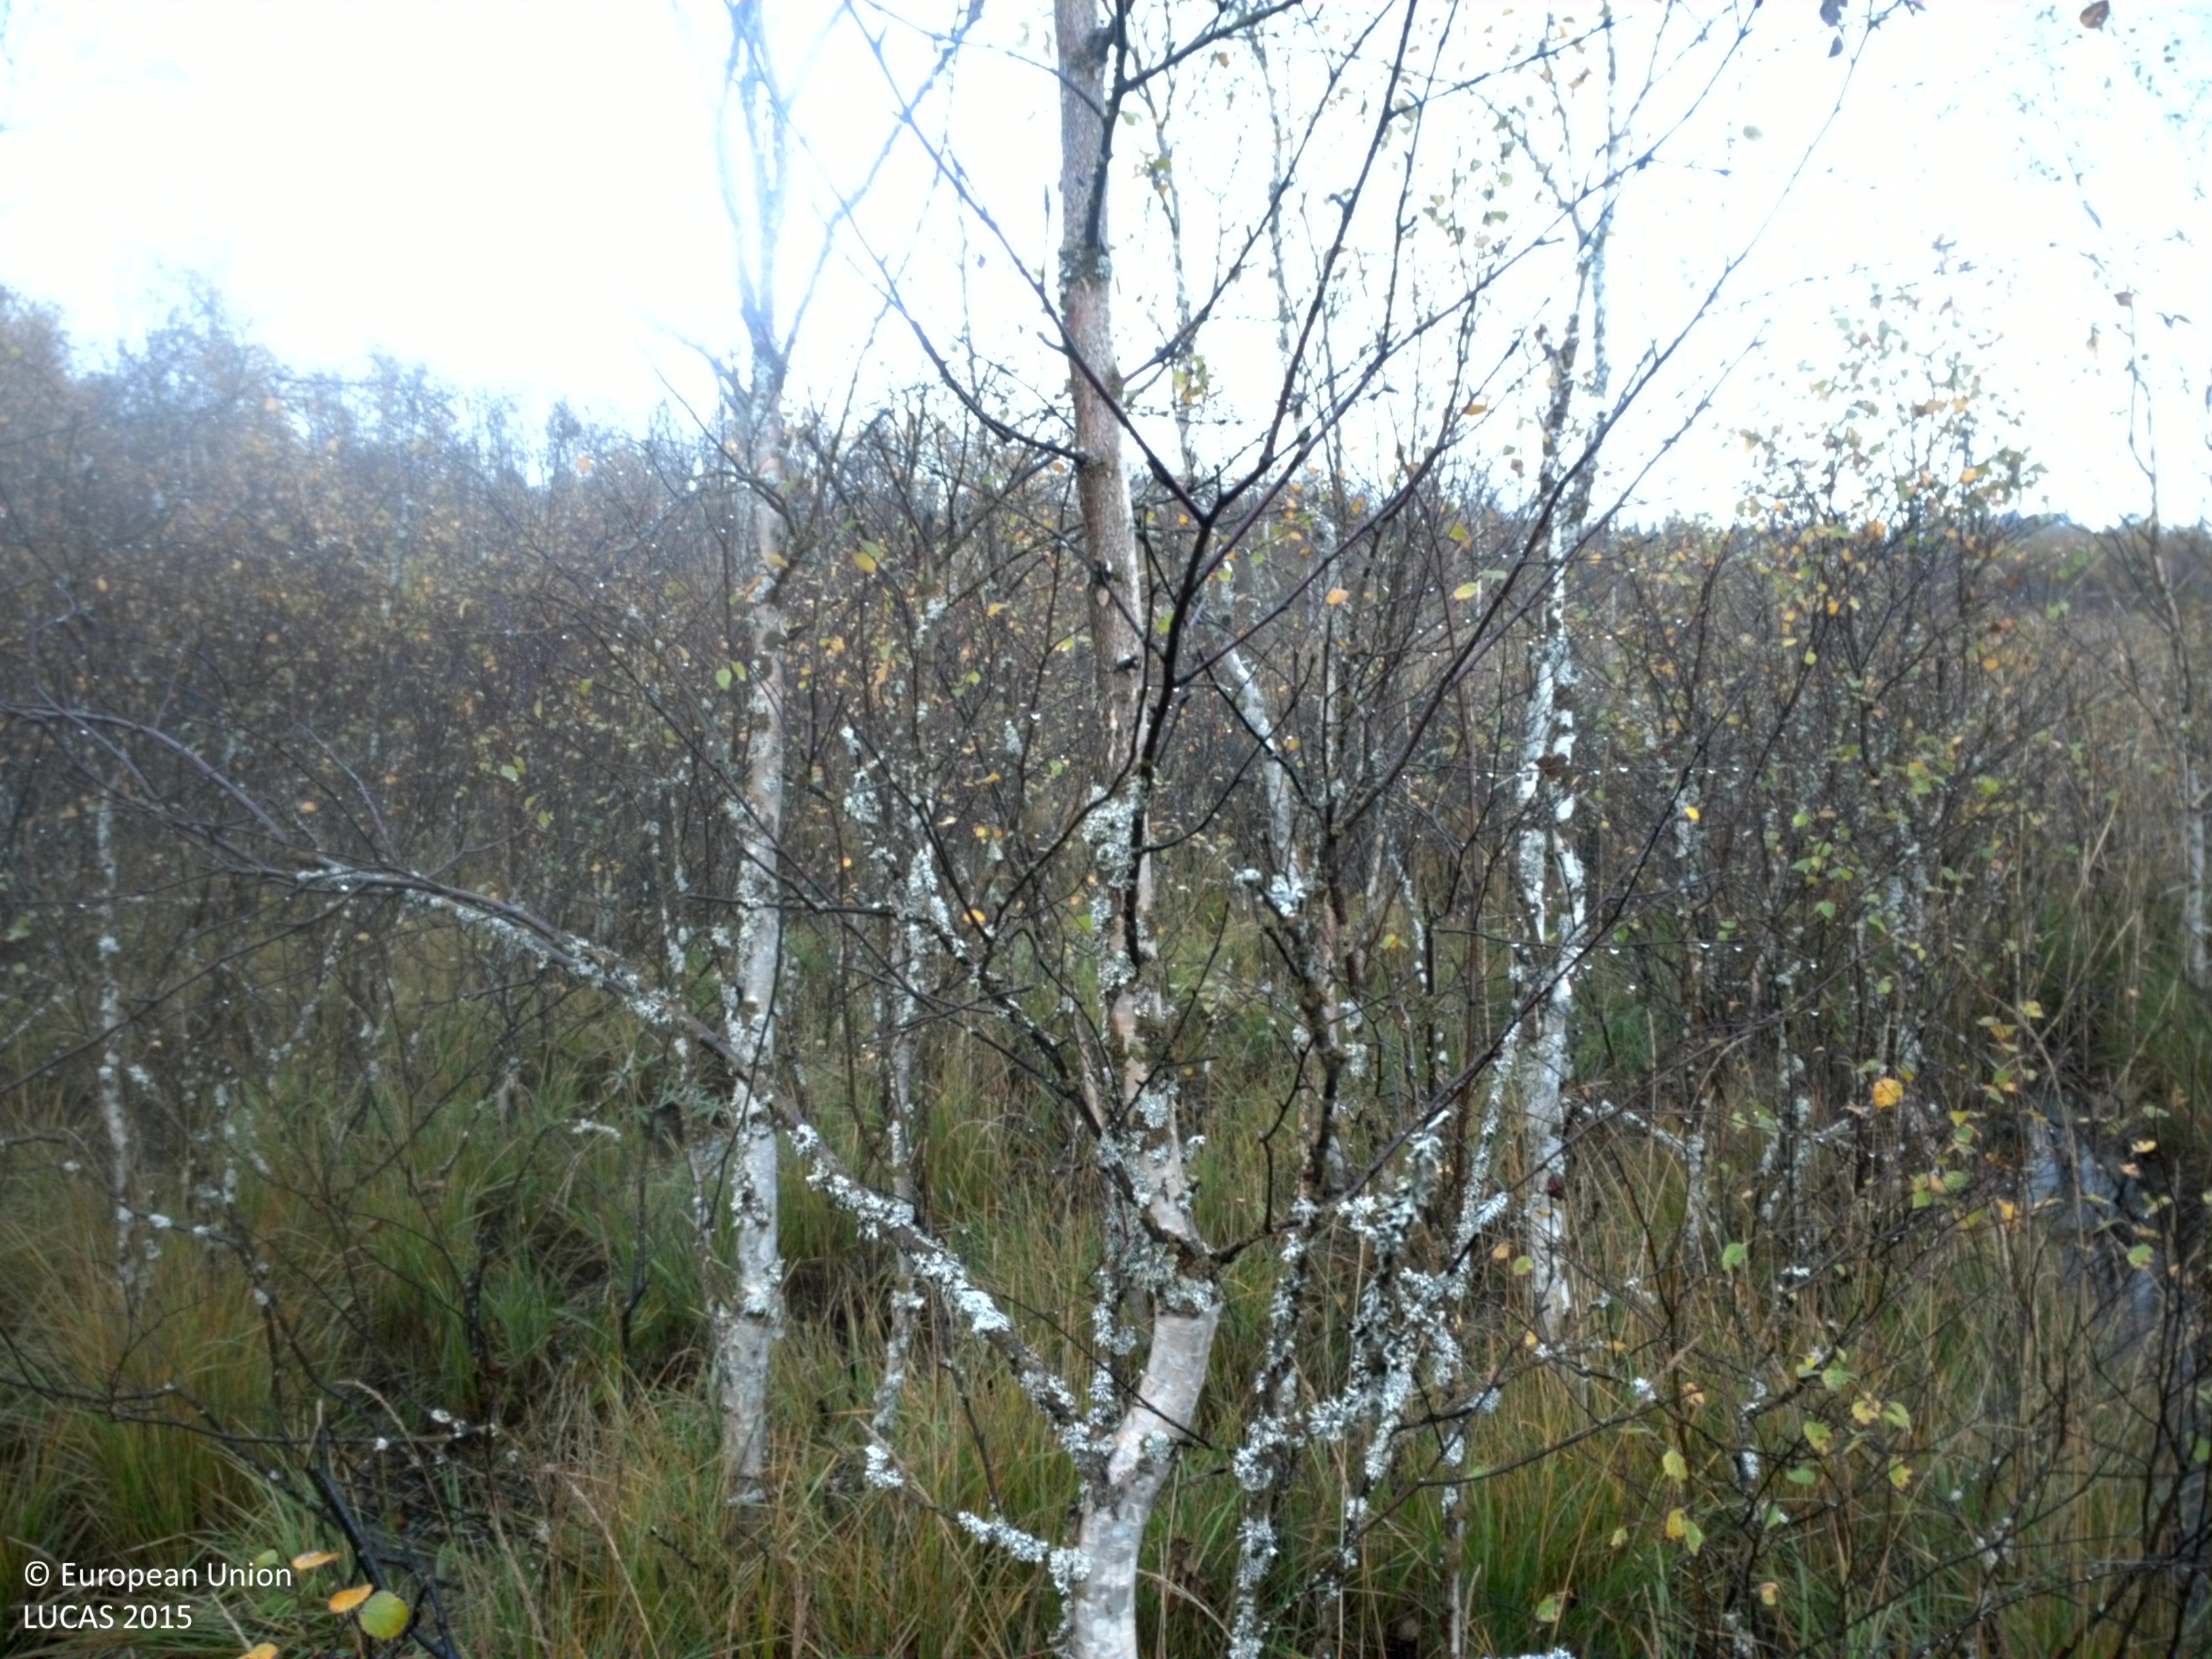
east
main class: Woodland
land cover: Broadleaved woodland
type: mire and swamp forests
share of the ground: 50 - 75 %
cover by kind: broadleaved forest trees 55 %, herbaceous plants 35 %
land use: Semi-natural and natural areas not in use
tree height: > 5 m
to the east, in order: Broadleaved woodland; Inland marshes; Broadleaved woodland; Grassland without tree/shrub cover
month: September
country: SE
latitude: 65.6393
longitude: 22.0801
